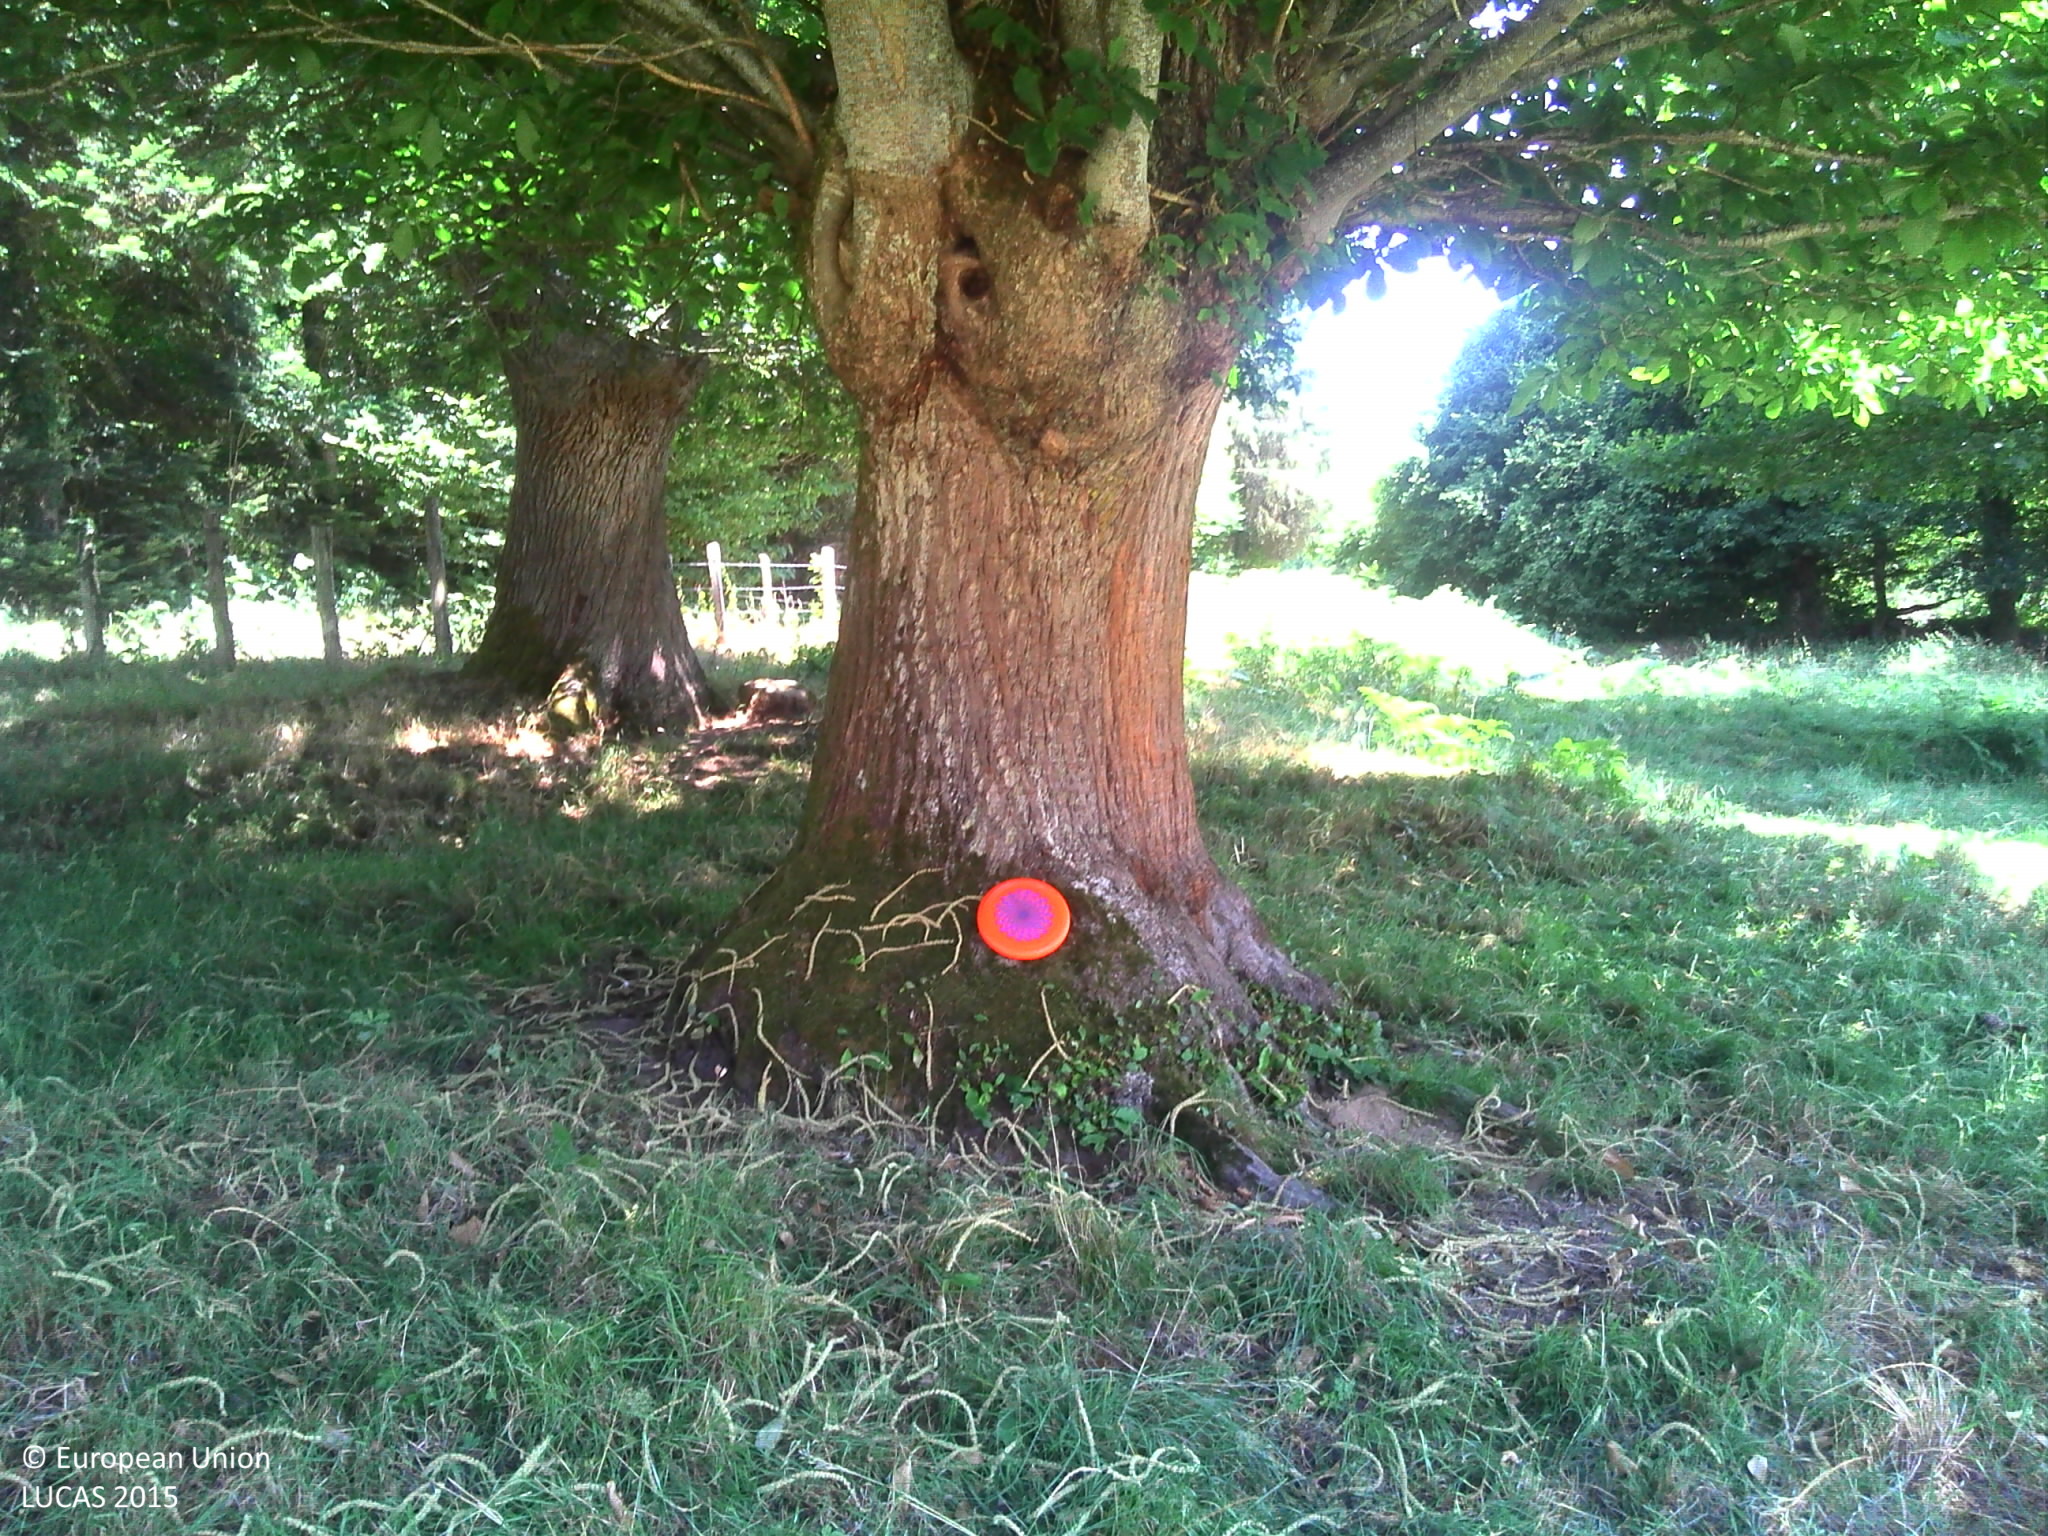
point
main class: Woodland
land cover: Broadleaved woodland
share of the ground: > 75 %
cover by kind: broadleaved forest trees 65 %, herbaceous plants 35 %
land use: Agriculture (excluding fallow land and kitchen gardens)
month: July
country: FR
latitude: 46.2039
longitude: 1.6323
